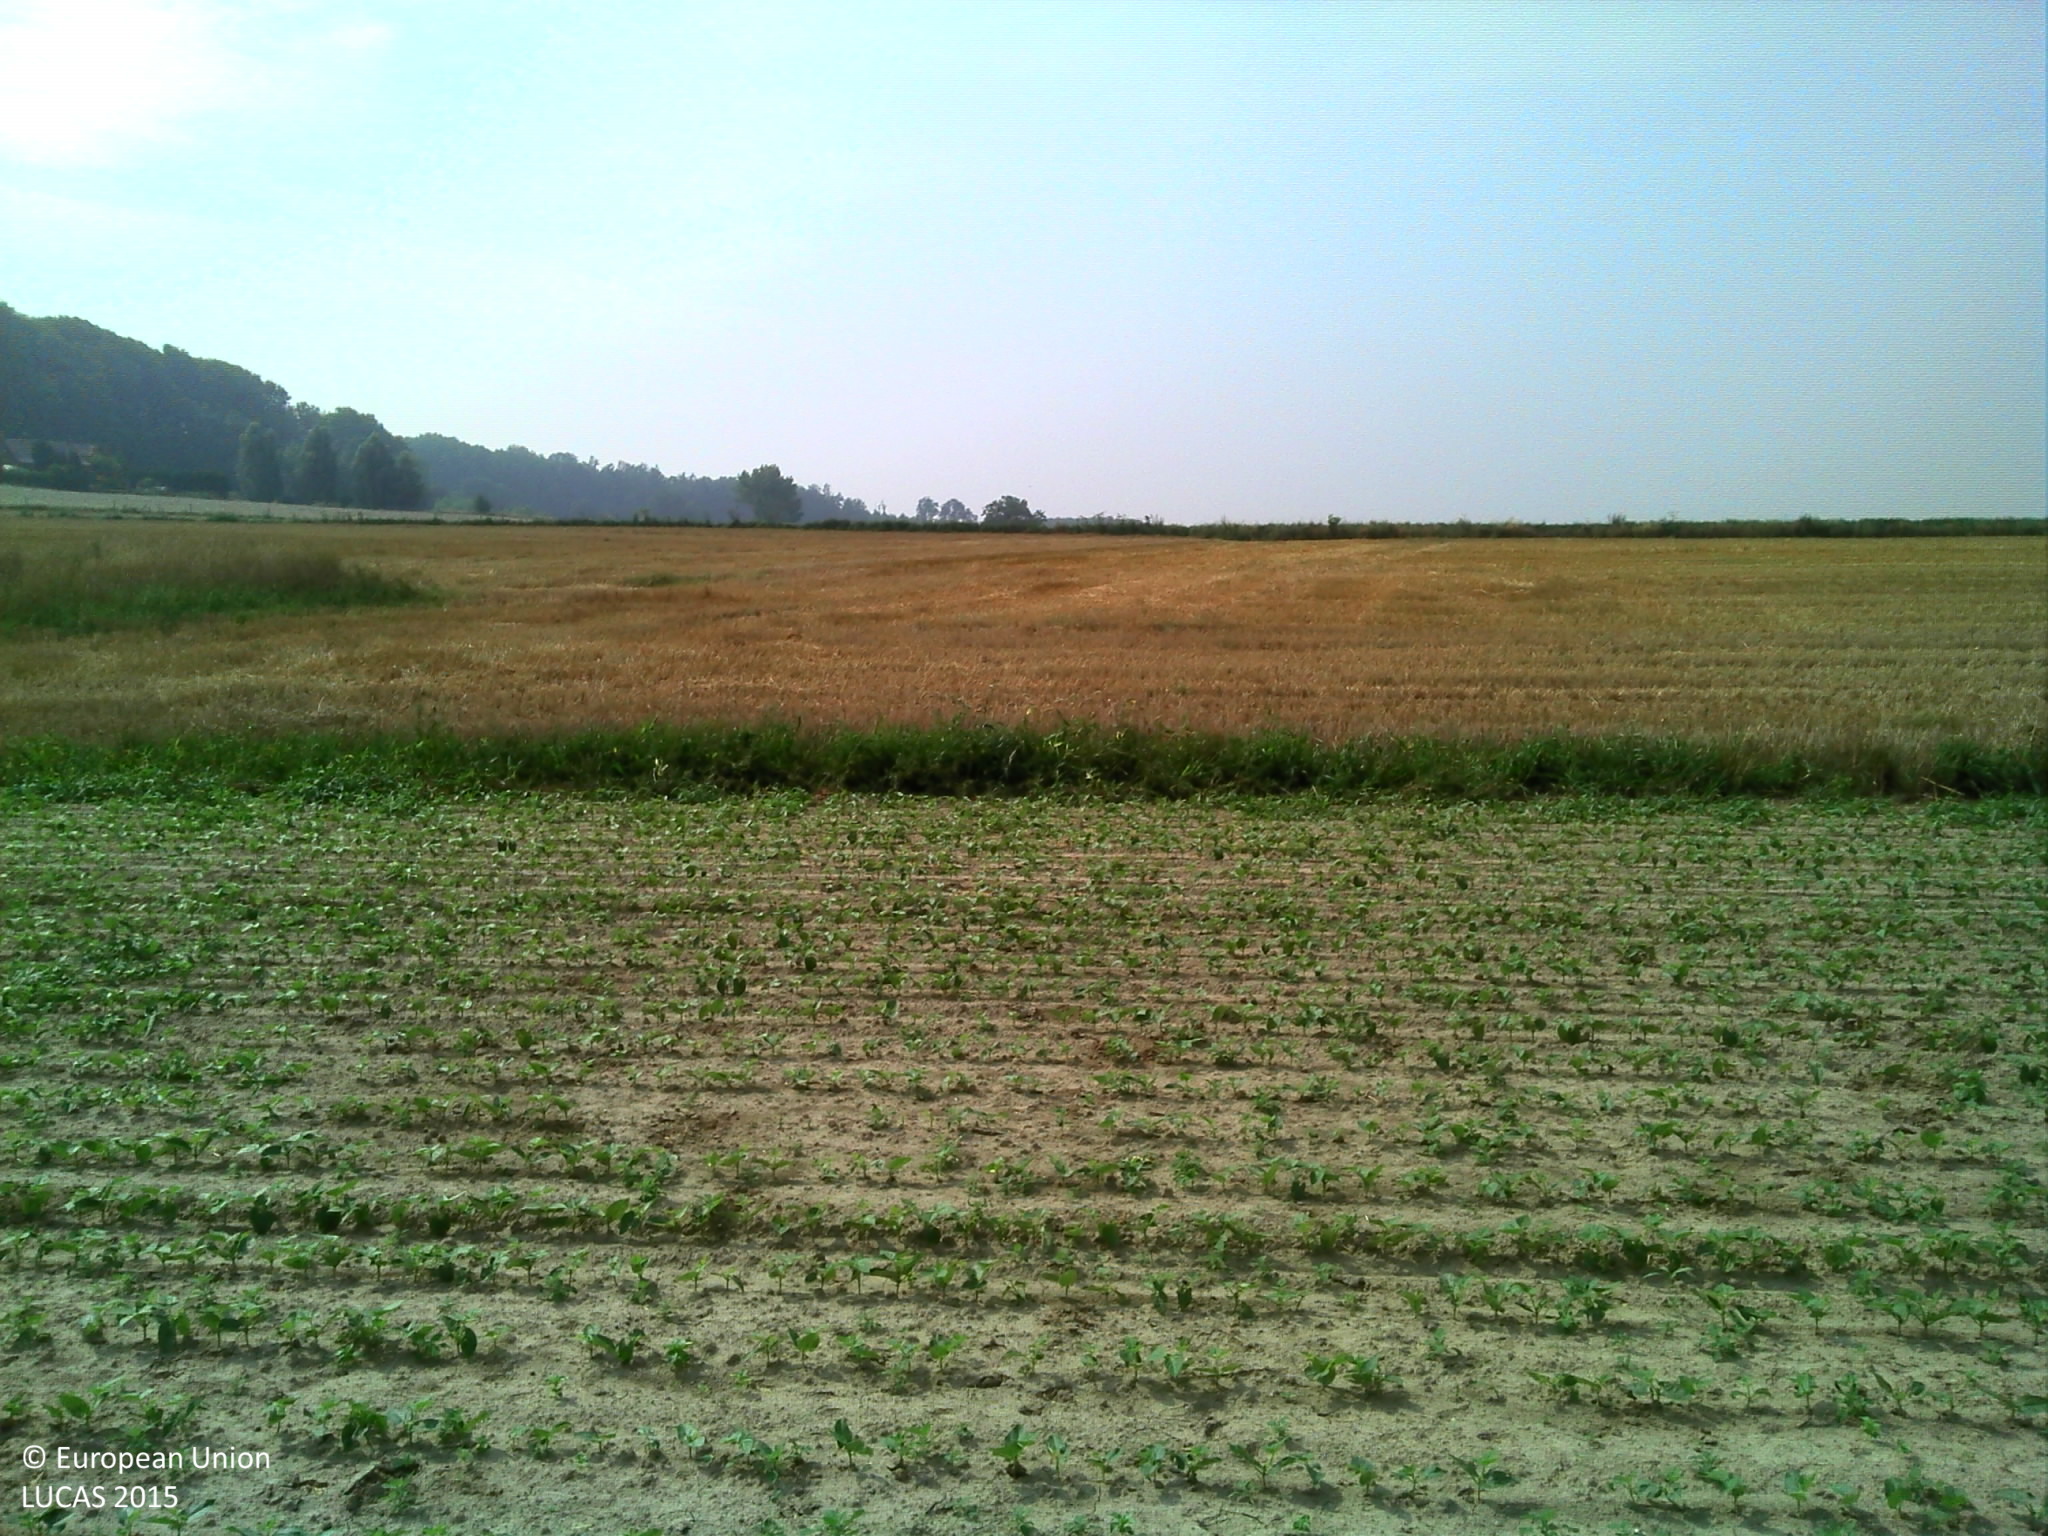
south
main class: Cropland
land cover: Other fresh vegetables
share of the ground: < 10 %
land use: Agriculture (excluding fallow land and kitchen gardens)
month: August
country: BE
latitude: 50.6319
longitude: 3.5314
